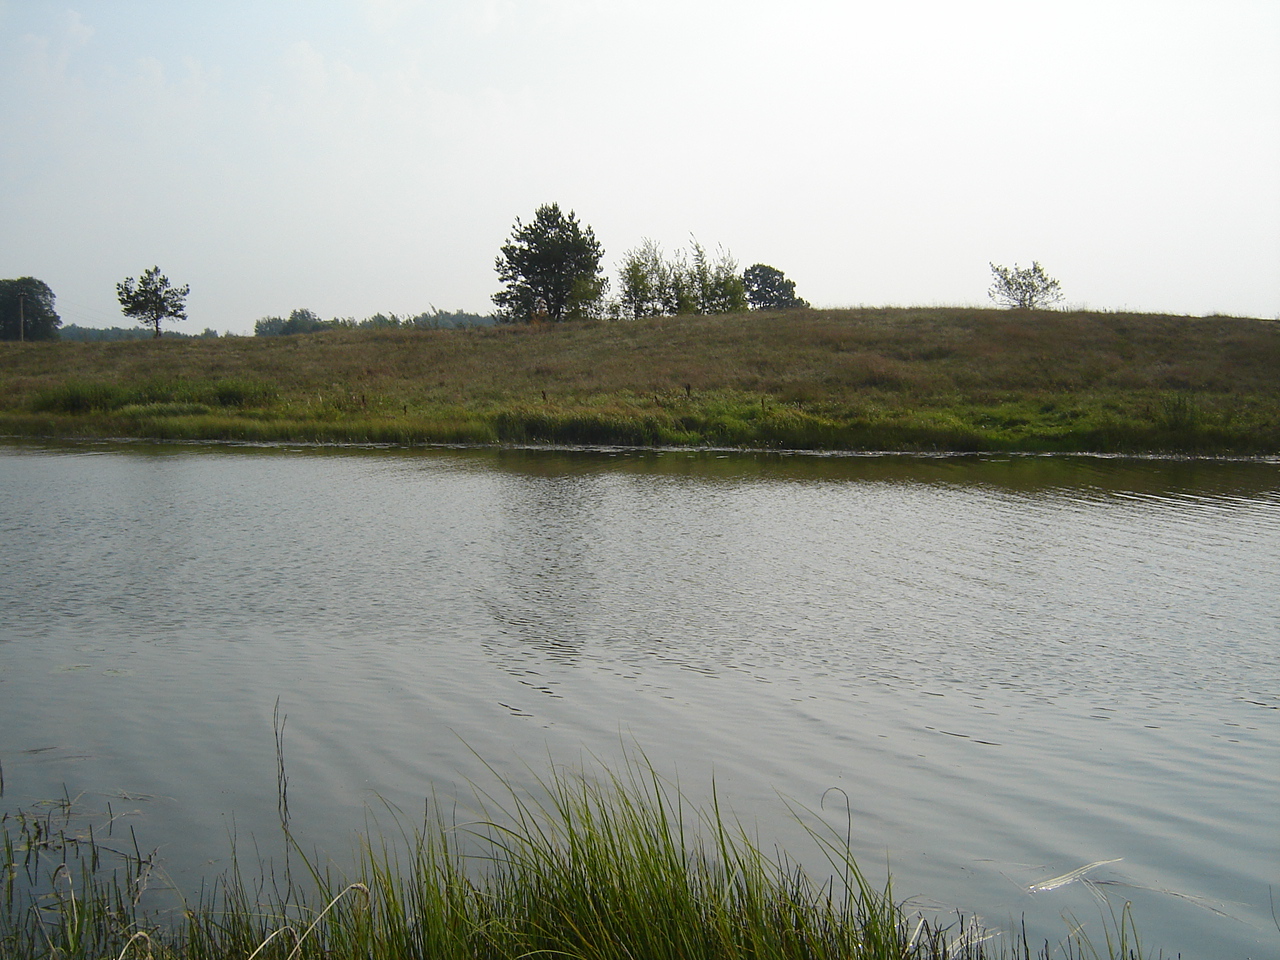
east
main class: Grassland
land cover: Spontaneously vegetated surfaces
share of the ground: > 75 %
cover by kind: herbaceous plants 100 %
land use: Semi-natural and natural areas not in use
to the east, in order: Inland fresh water bodies; Spontaneously vegetated surfaces; Grassland without tree/shrub cover; Tracks; Broadleaved woodland; Spontaneously vegetated surfaces; Inland fresh water bodies; Spontaneously vegetated surfaces; Grassland without tree/shrub cover; Electric lines; Grassland without tree/shrub cover; Fences; Lines of trees; Grassland without tree/shrub cover; Apple fruit; Potatoes
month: September
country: LT
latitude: 54.5462
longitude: 25.1601
